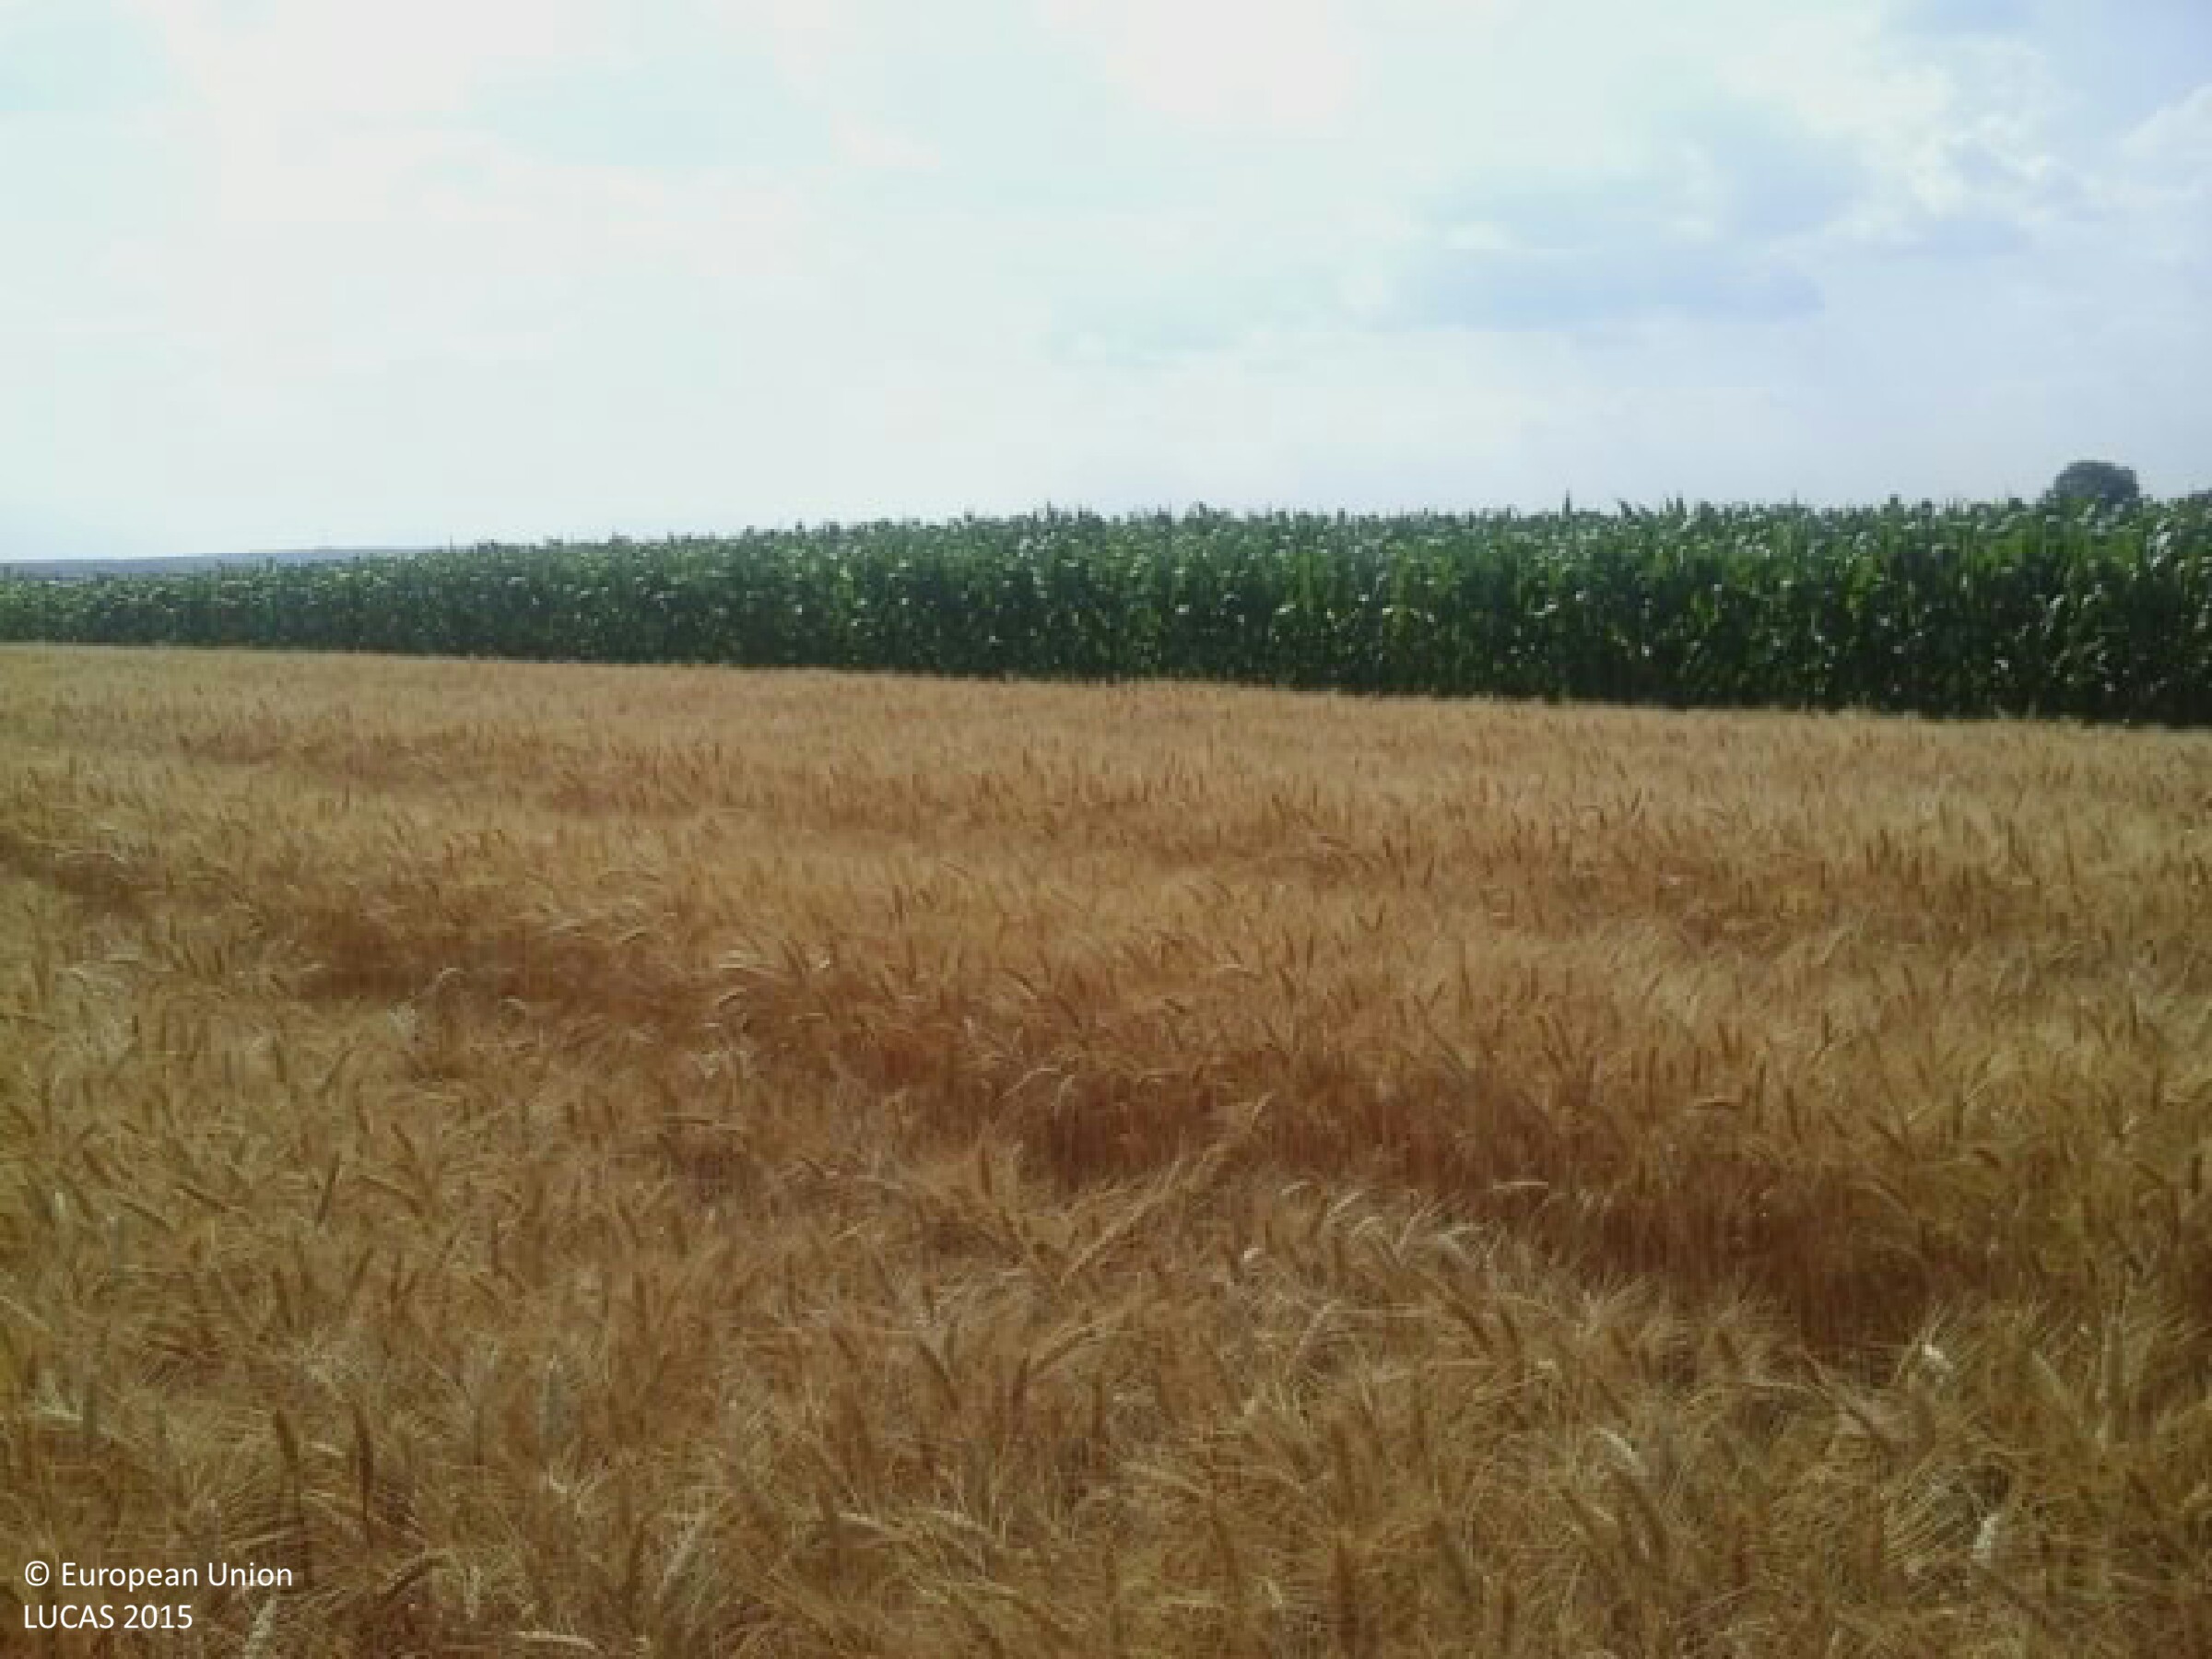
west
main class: Cropland
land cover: Common wheat
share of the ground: > 75 %
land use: Agriculture (excluding fallow land and kitchen gardens)
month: July
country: HU
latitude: 46.6624
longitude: 18.9664
